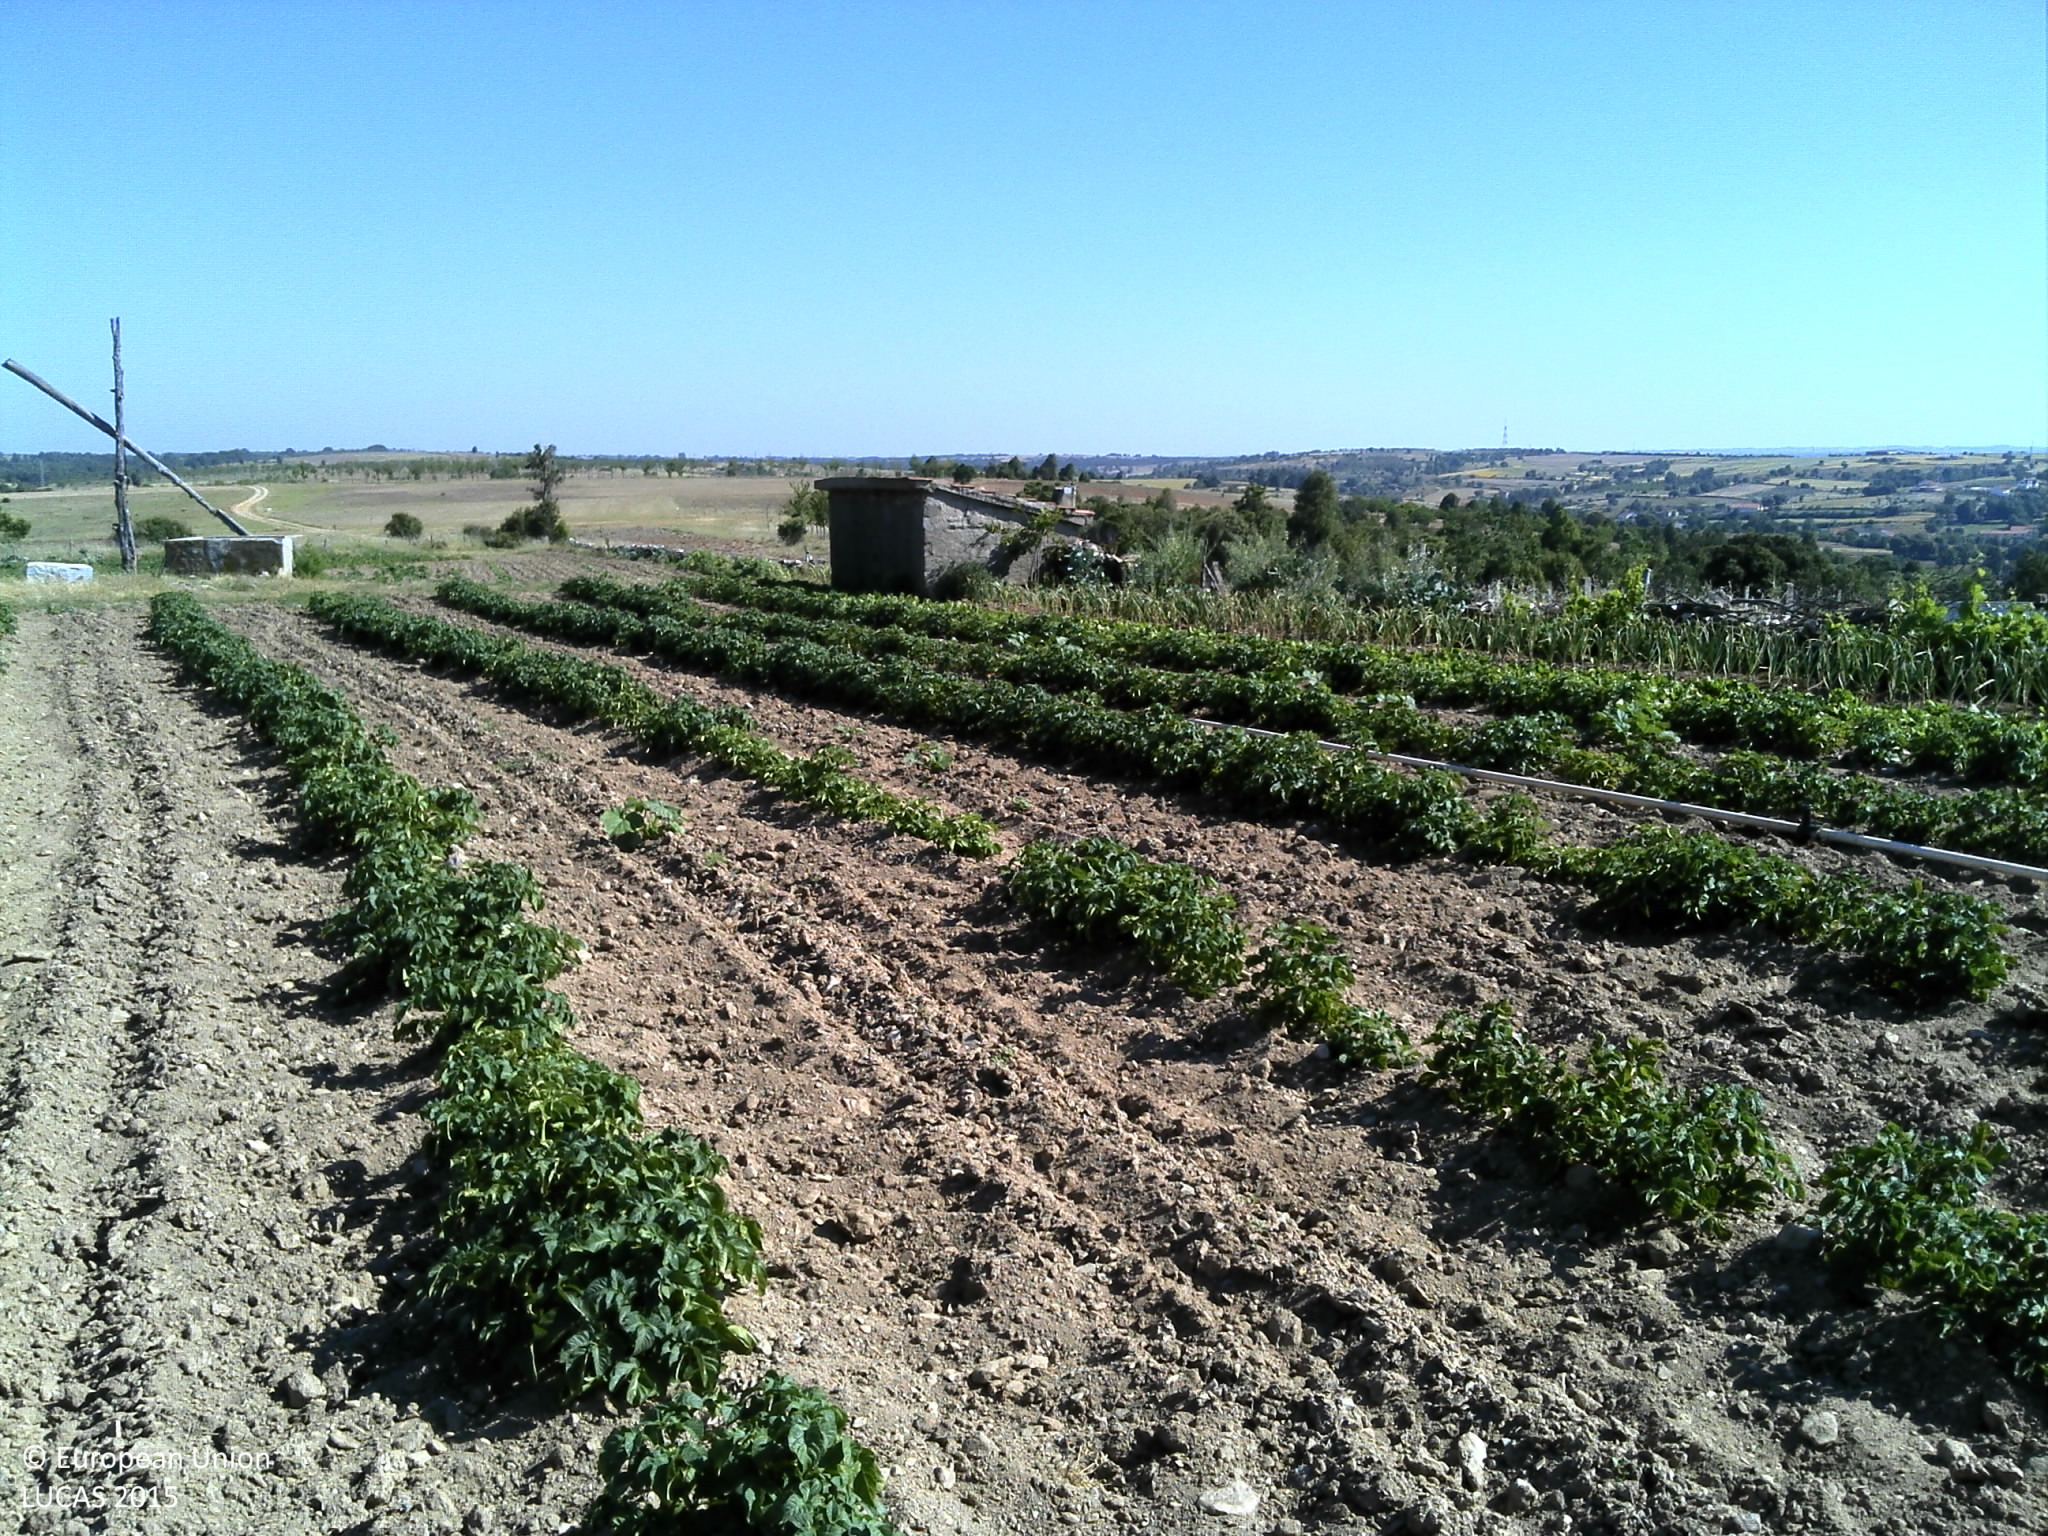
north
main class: Cropland
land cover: Potatoes
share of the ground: < 10 %
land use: Agriculture (excluding fallow land and kitchen gardens)
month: May
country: PT
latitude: 41.4667
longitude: -6.3221
